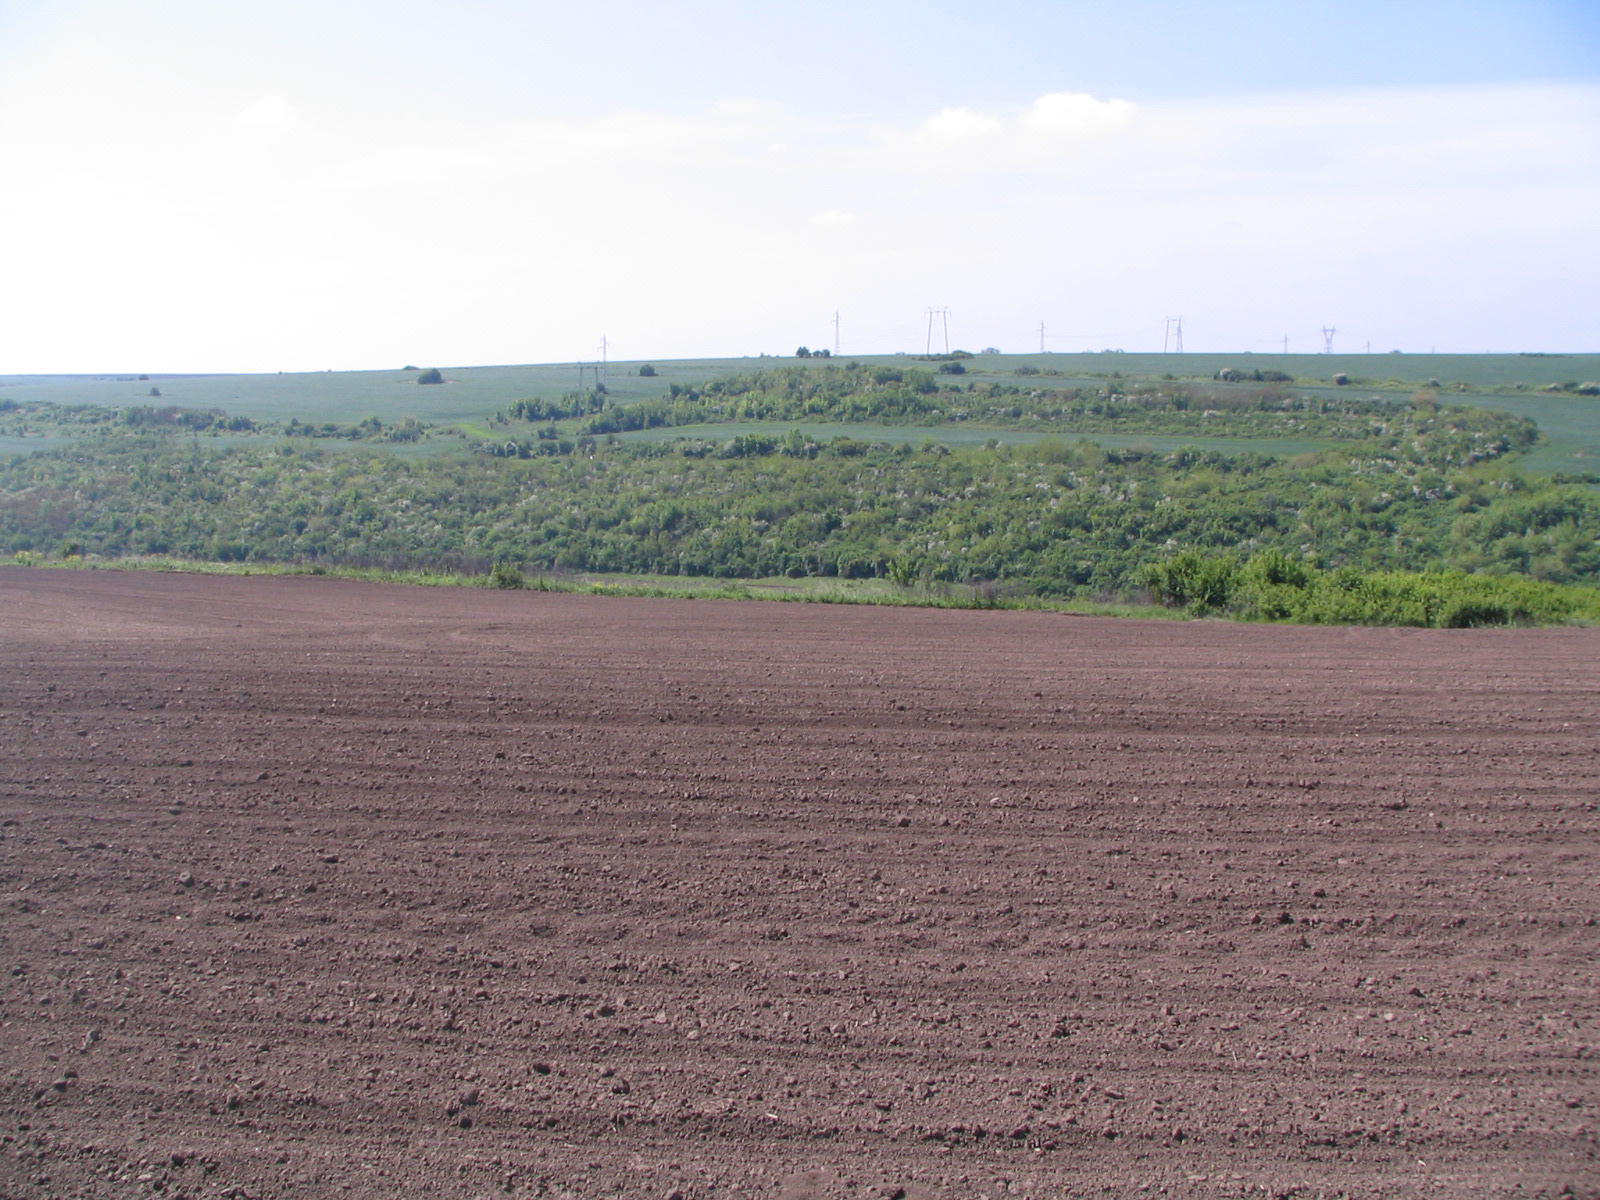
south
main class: Cropland
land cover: Maize
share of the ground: < 10 %
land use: Agriculture (excluding fallow land and kitchen gardens)
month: May
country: BG
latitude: 43.7181
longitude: 23.9179
